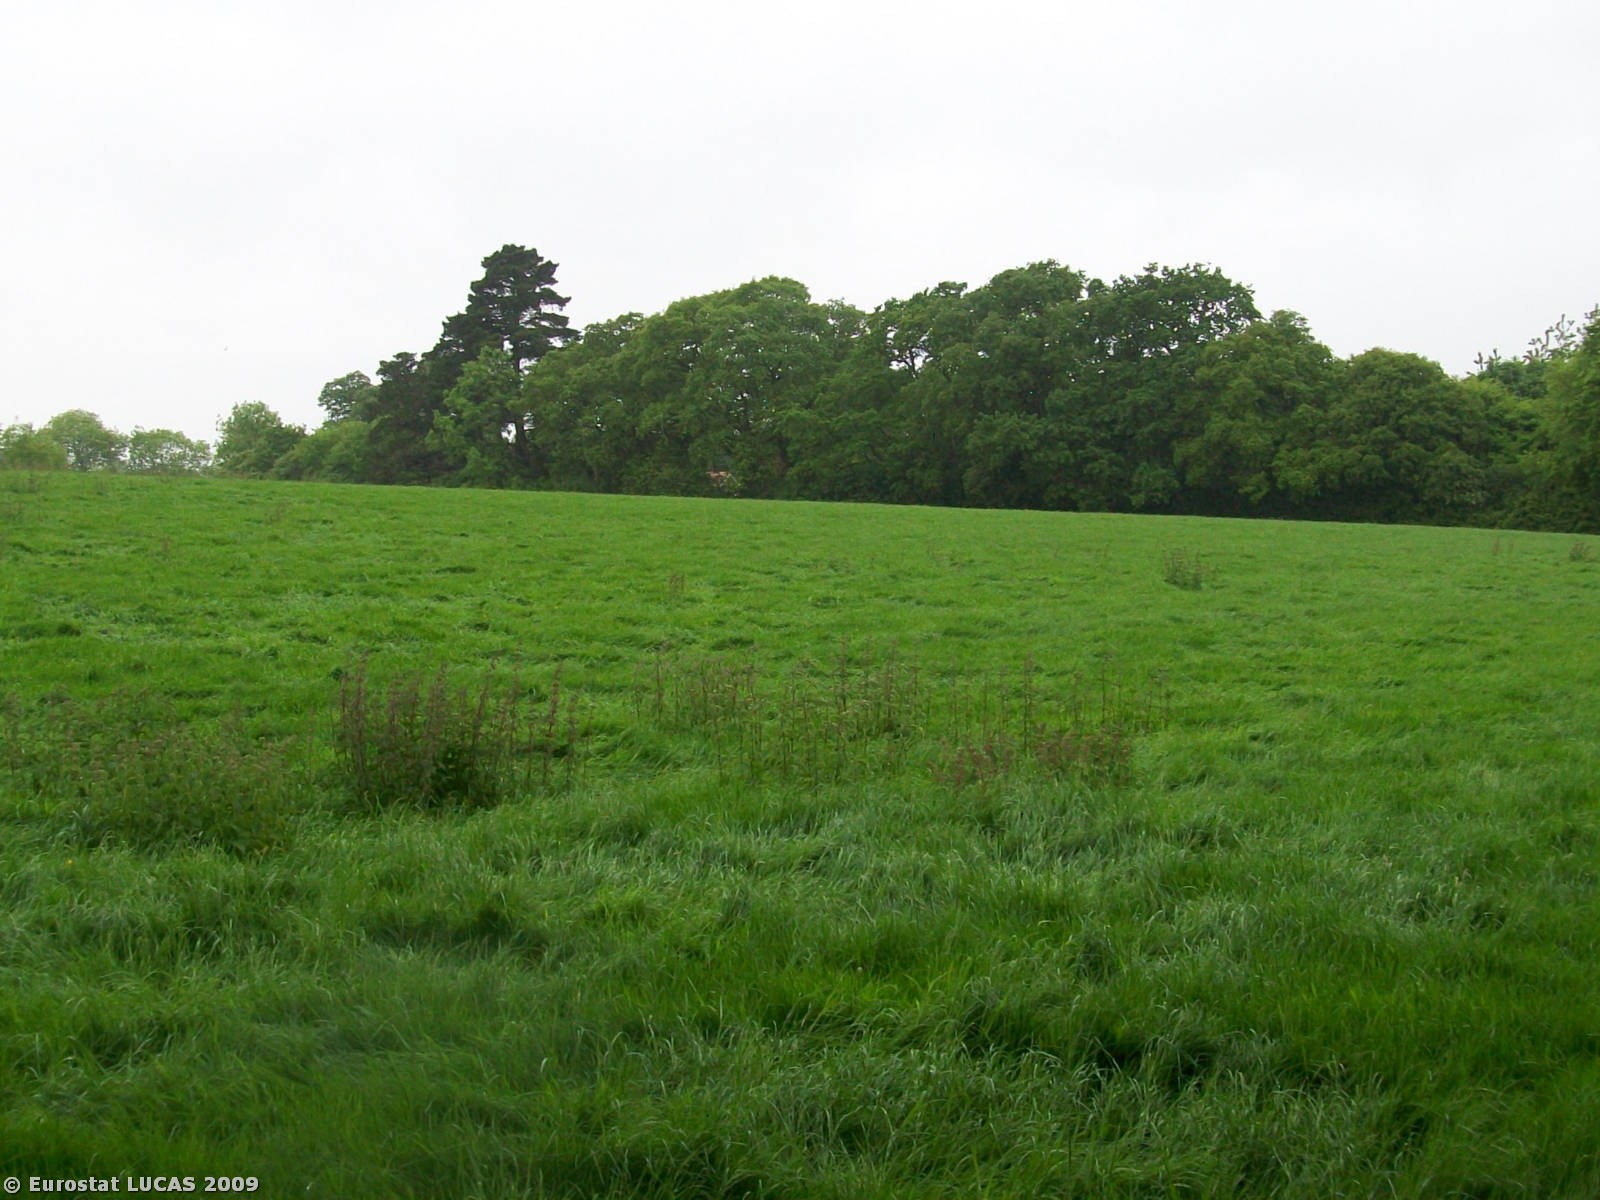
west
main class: Grassland
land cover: Grassland without tree/shrub cover
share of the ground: > 75 %
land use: Agriculture (excluding fallow land and kitchen gardens)
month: May
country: GB
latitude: 50.7636
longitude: -3.3369
